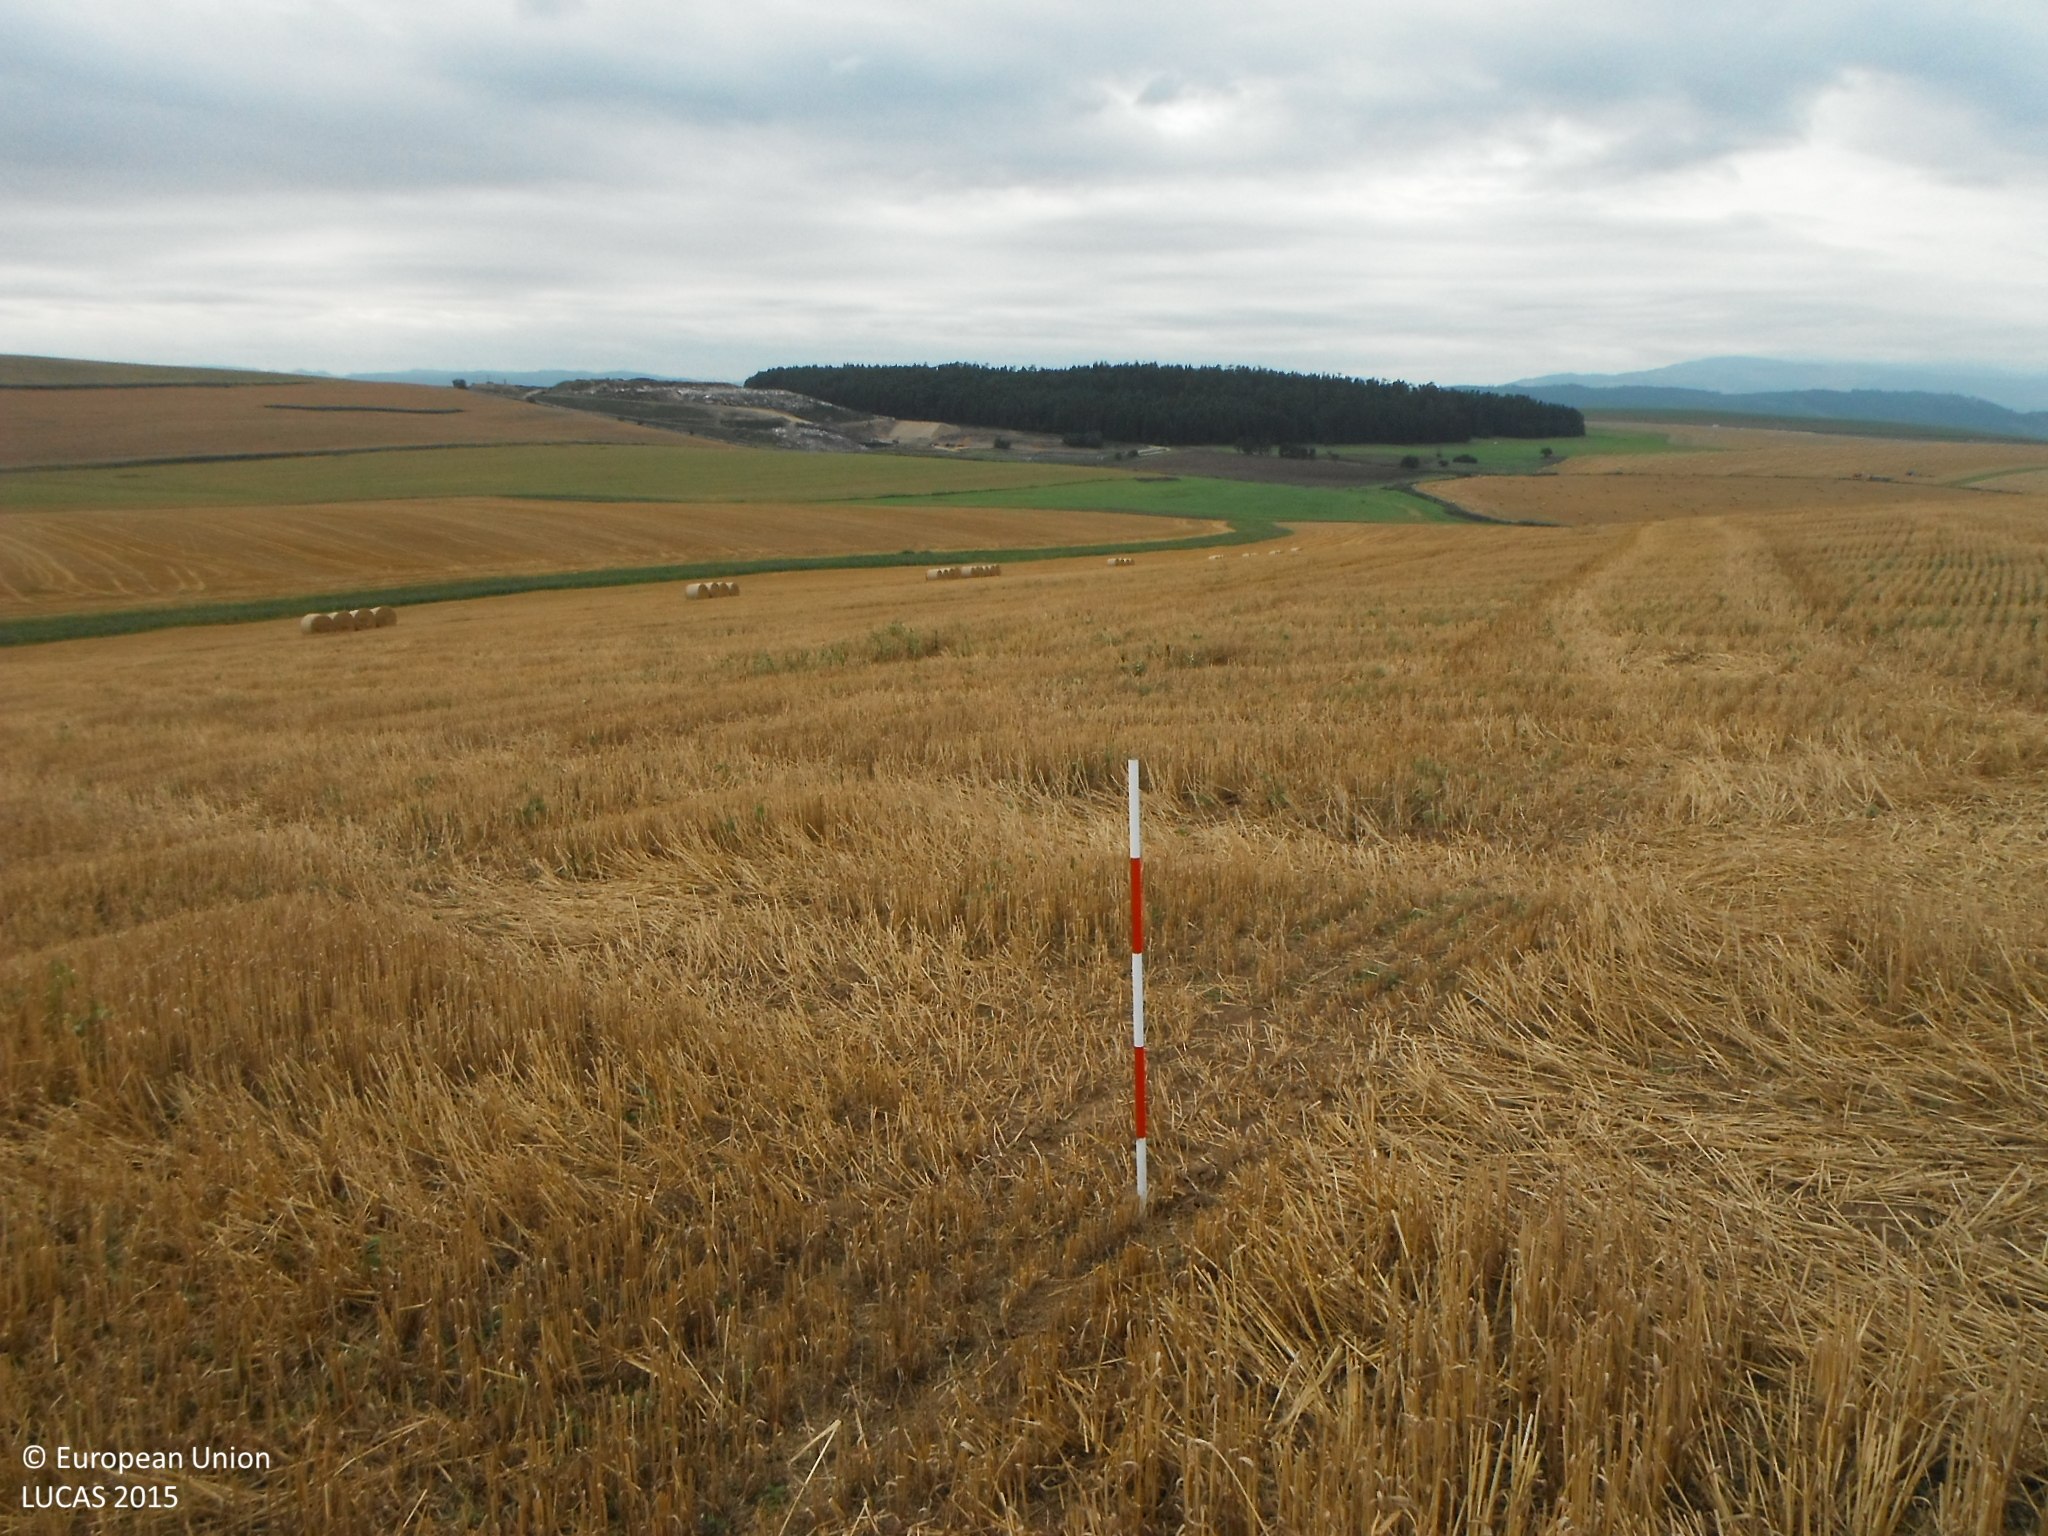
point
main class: Cropland
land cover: Barley
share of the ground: > 75 %
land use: Agriculture (excluding fallow land and kitchen gardens)
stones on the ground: 25 - 50 %
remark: Harvested field
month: August
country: SK
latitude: 49.0753
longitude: 20.3704
